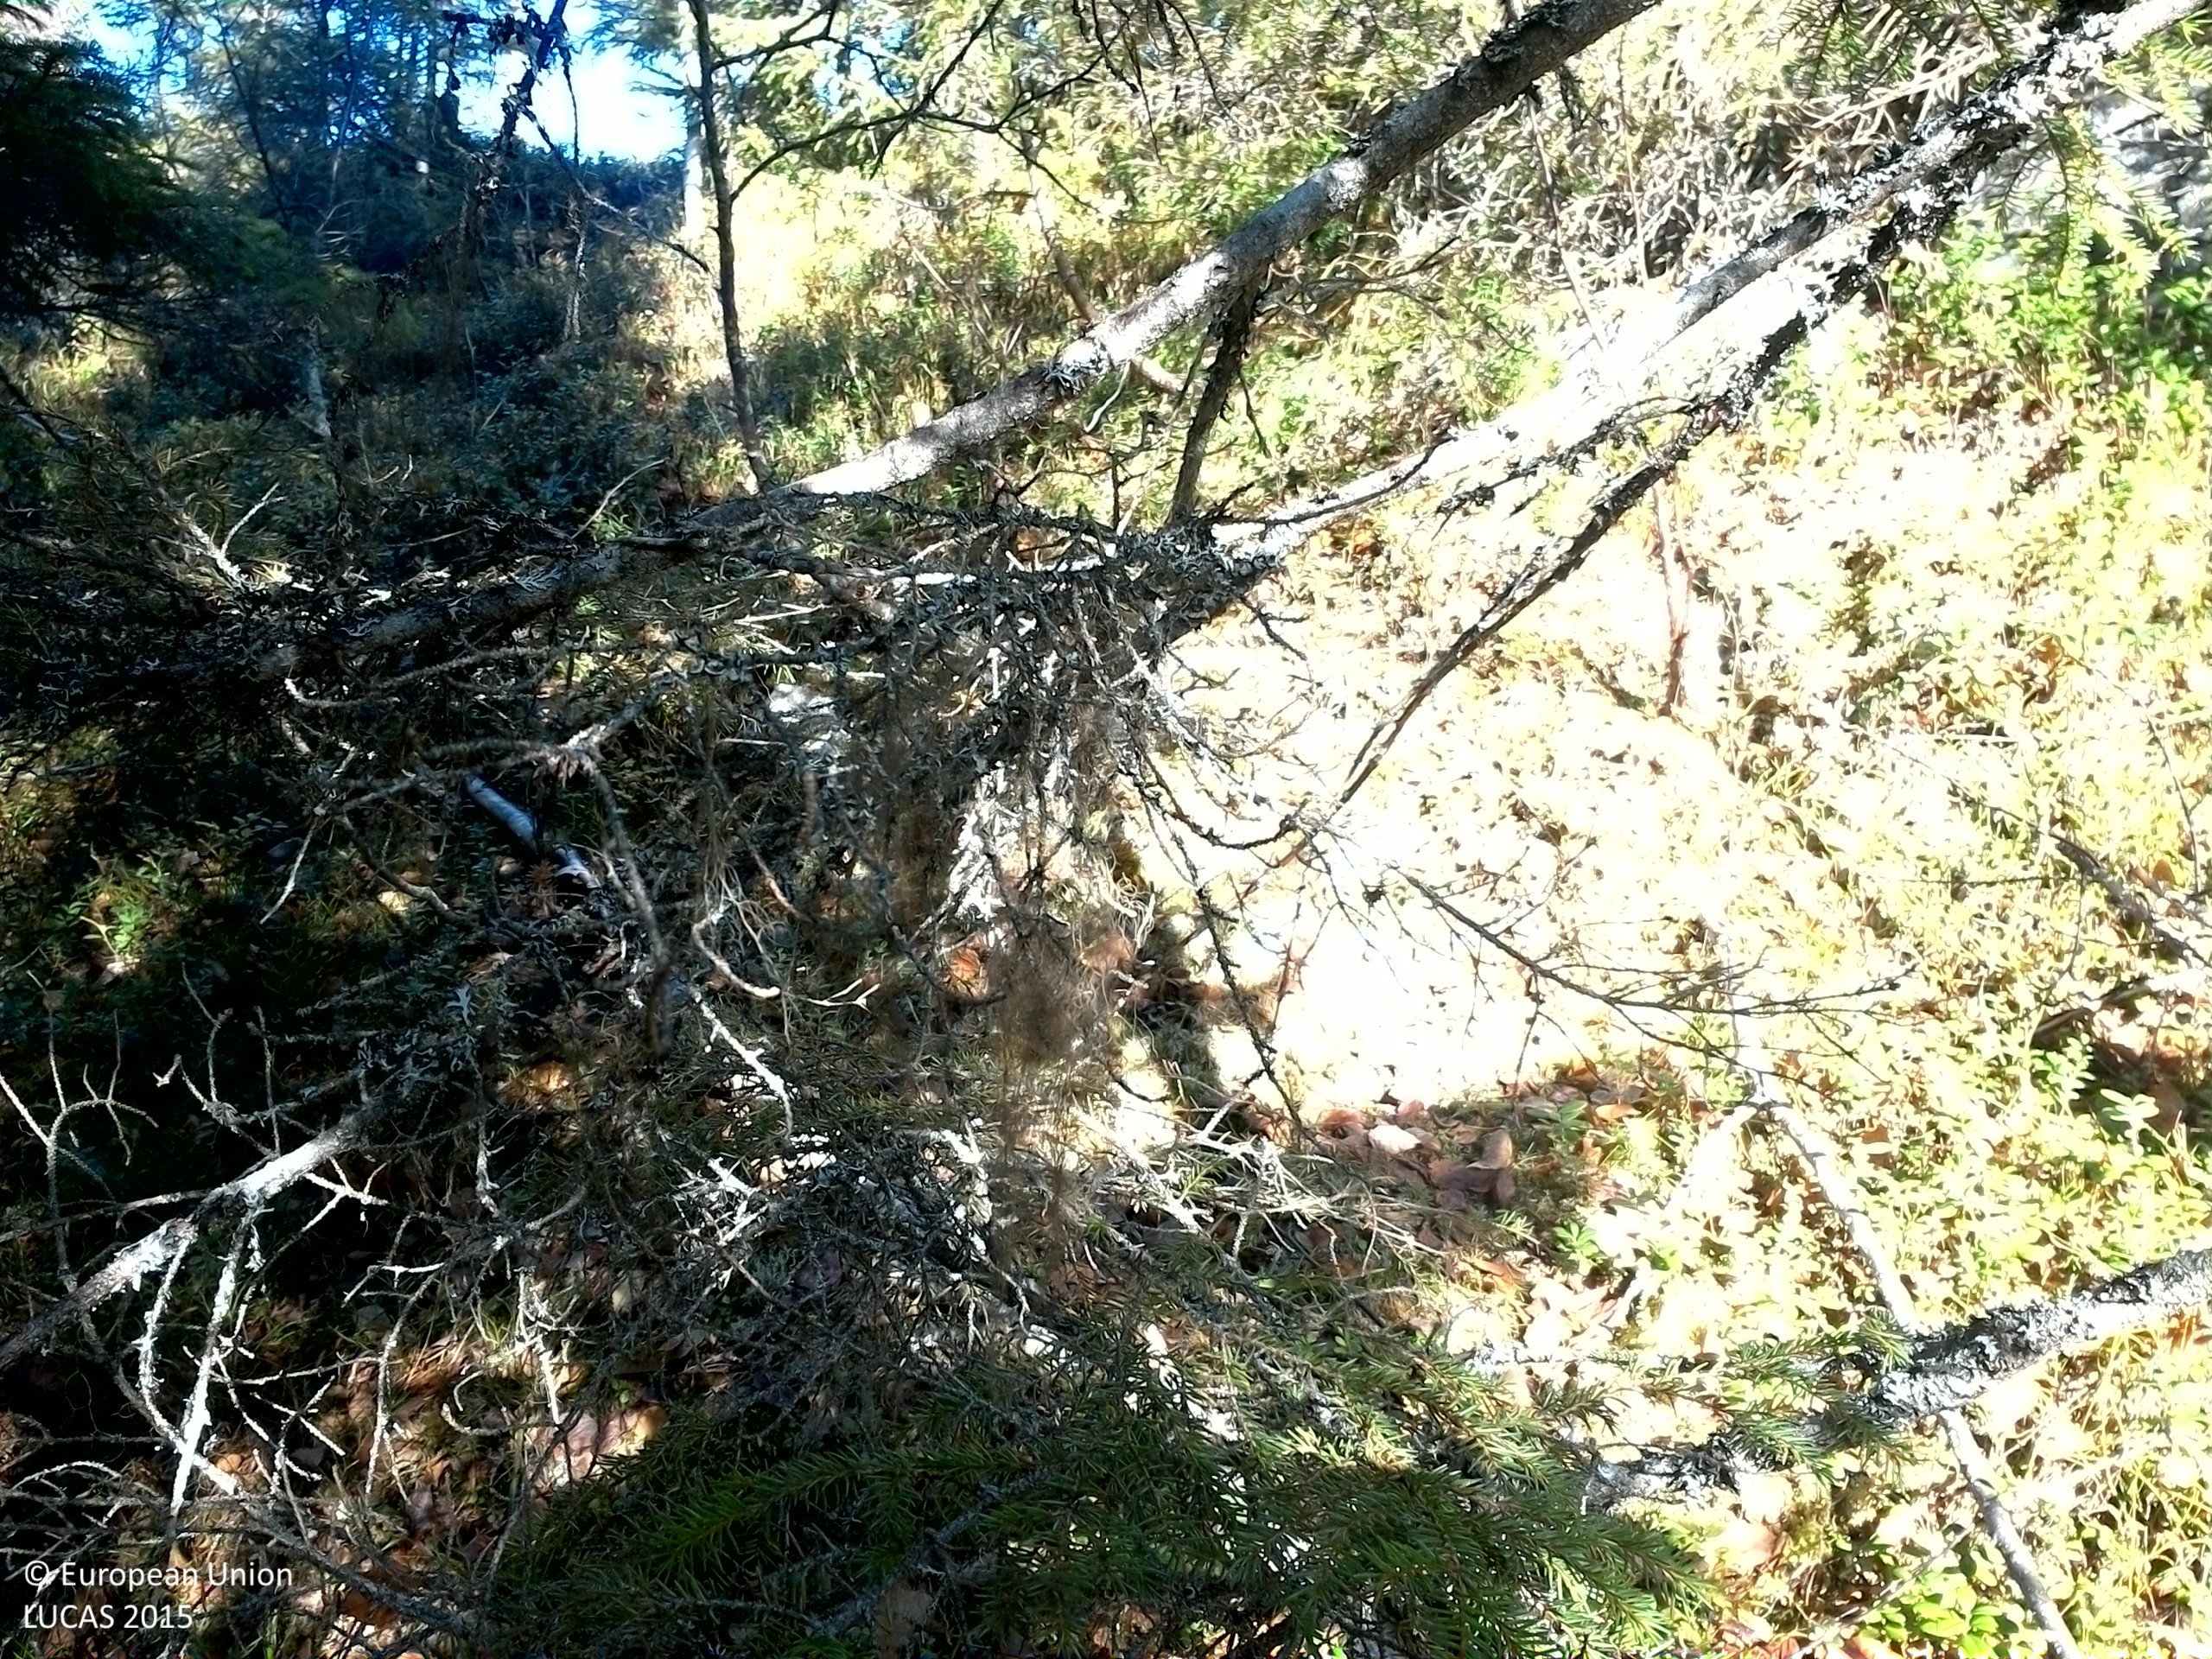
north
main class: Woodland
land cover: Spruce dominated mixed woodland
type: boreal forest
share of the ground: 25 - 50 %
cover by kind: coniferous forest trees 30 %, shrubs 30 %, lichens and mosses 20 %, broadleaved forest trees 10 %, consolidated bare surface 10 %
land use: Forestry
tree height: > 5 m
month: October
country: SE
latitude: 64.5052
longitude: 15.4050
